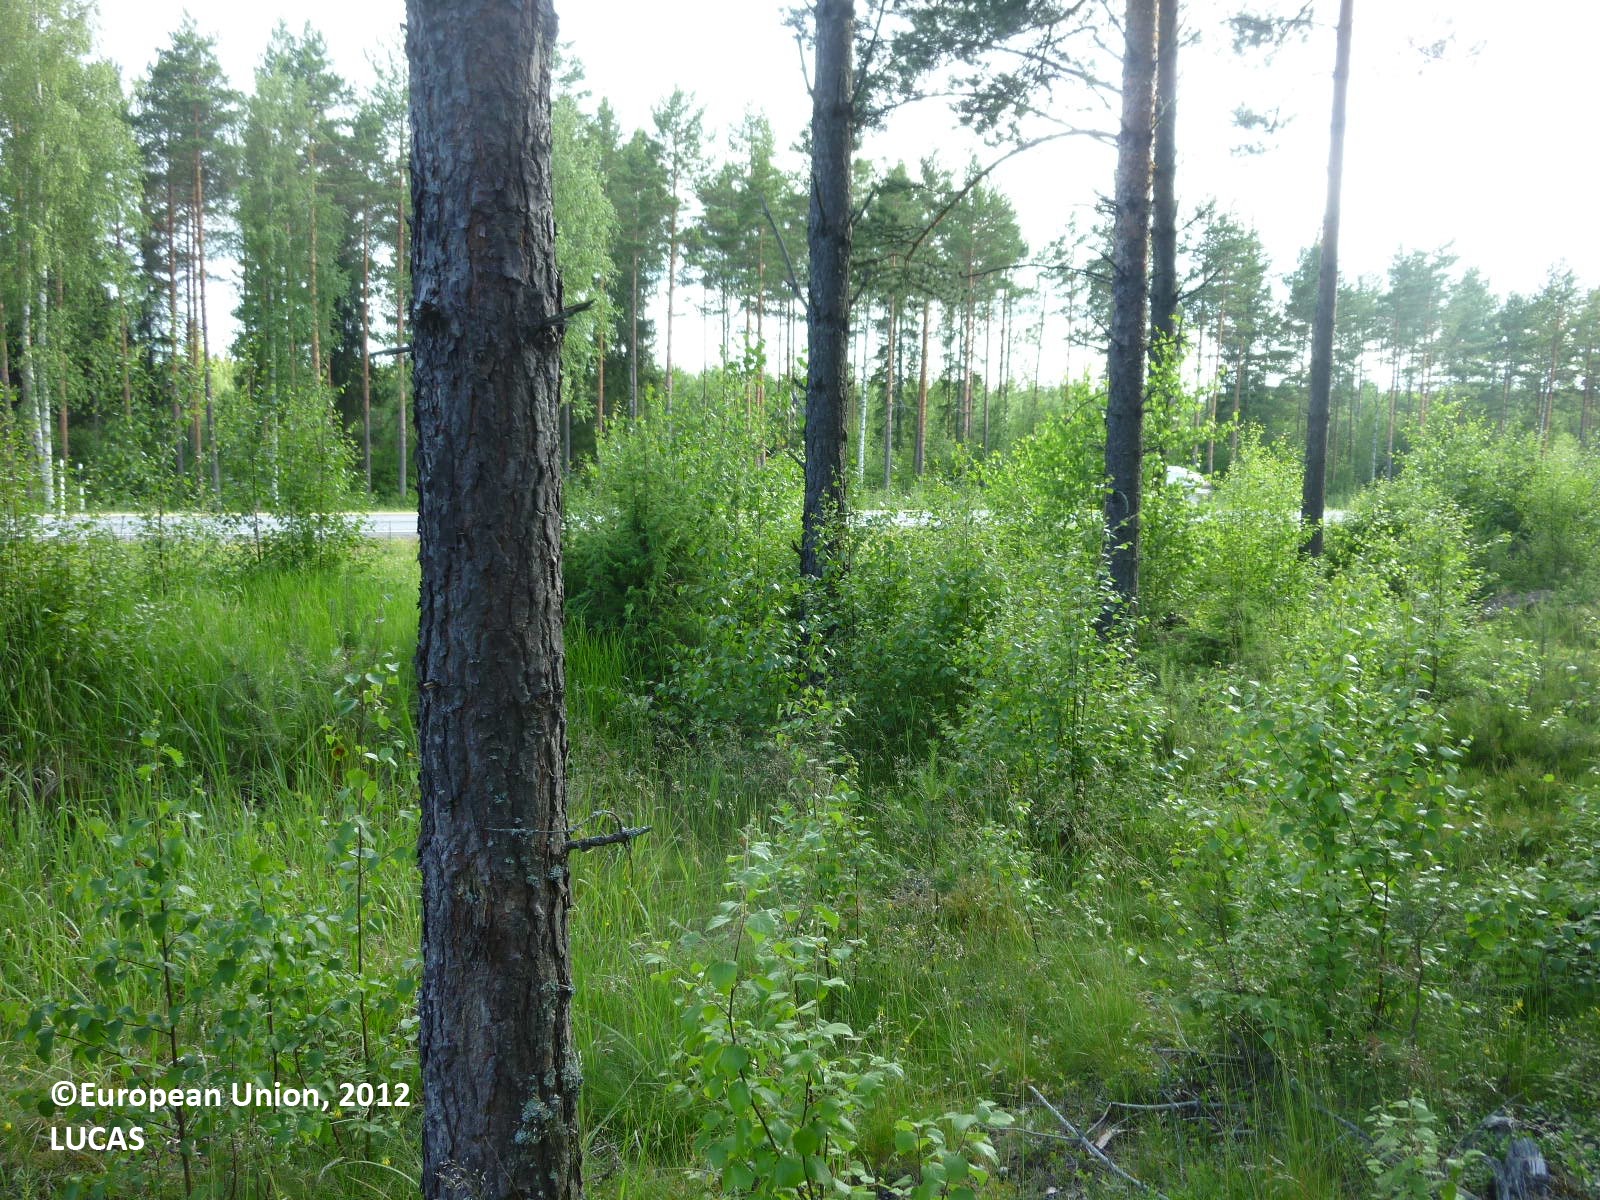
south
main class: Woodland
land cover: Pine dominated coniferous woodland
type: boreal forest
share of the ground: 50 - 75 %
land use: Forestry
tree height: > 5 m
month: July
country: FI
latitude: 61.1661
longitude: 22.3880
